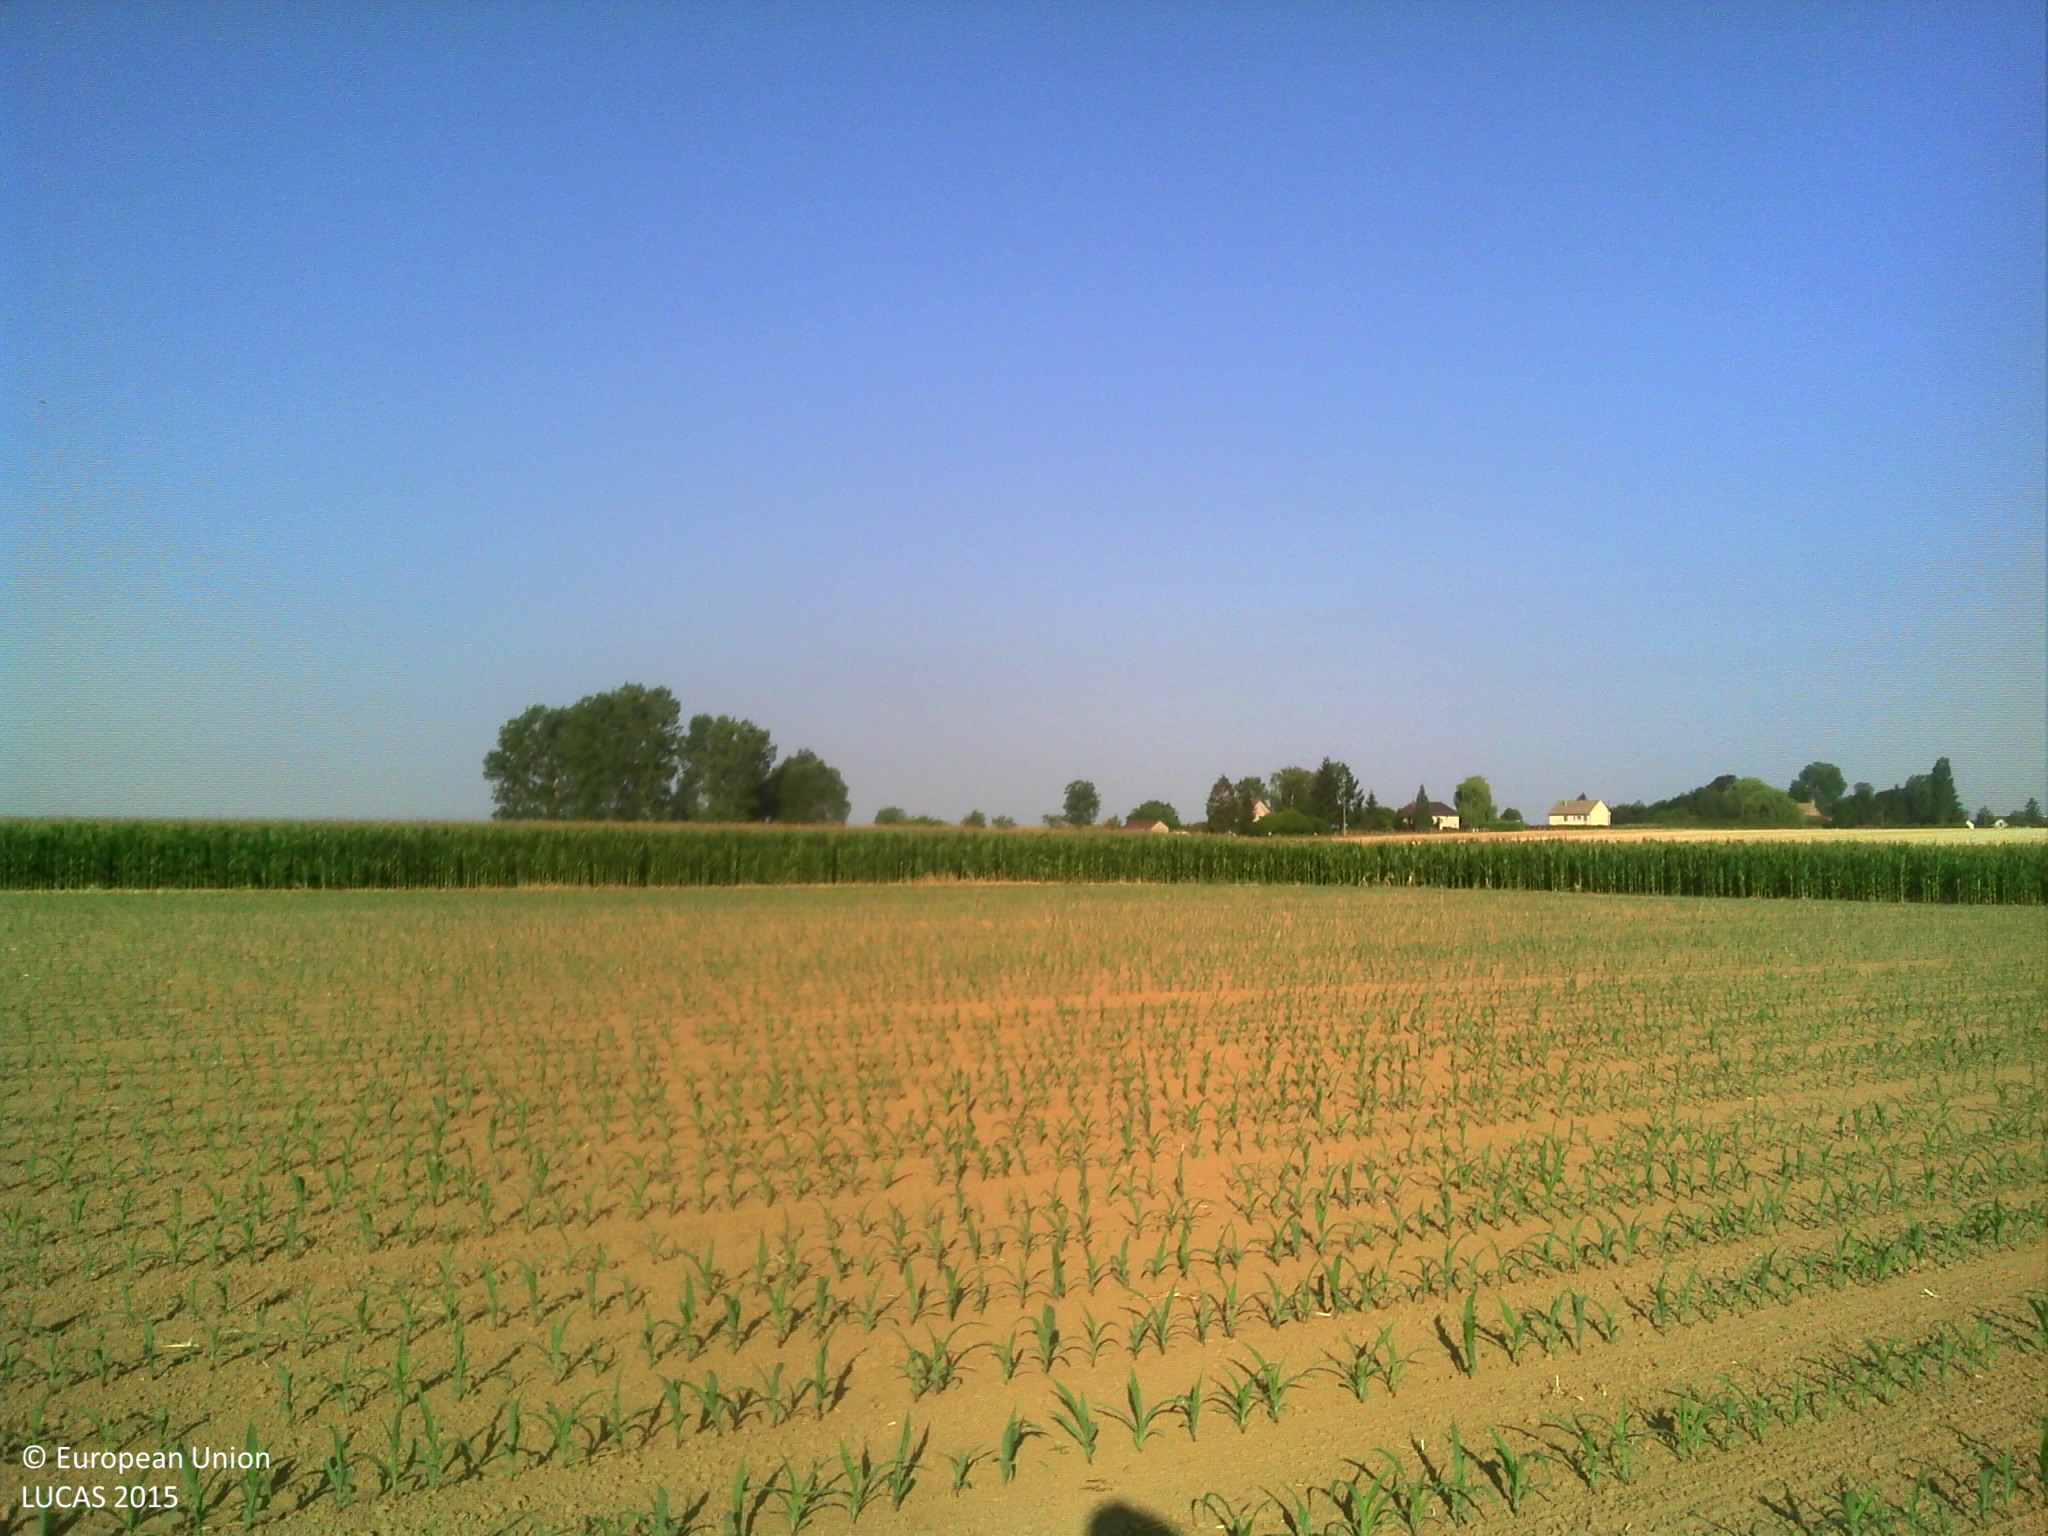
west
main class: Cropland
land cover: Maize
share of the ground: < 10 %
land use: Agriculture (excluding fallow land and kitchen gardens)
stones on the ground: < 10 %
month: July
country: FR
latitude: 46.8492
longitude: 5.0311
